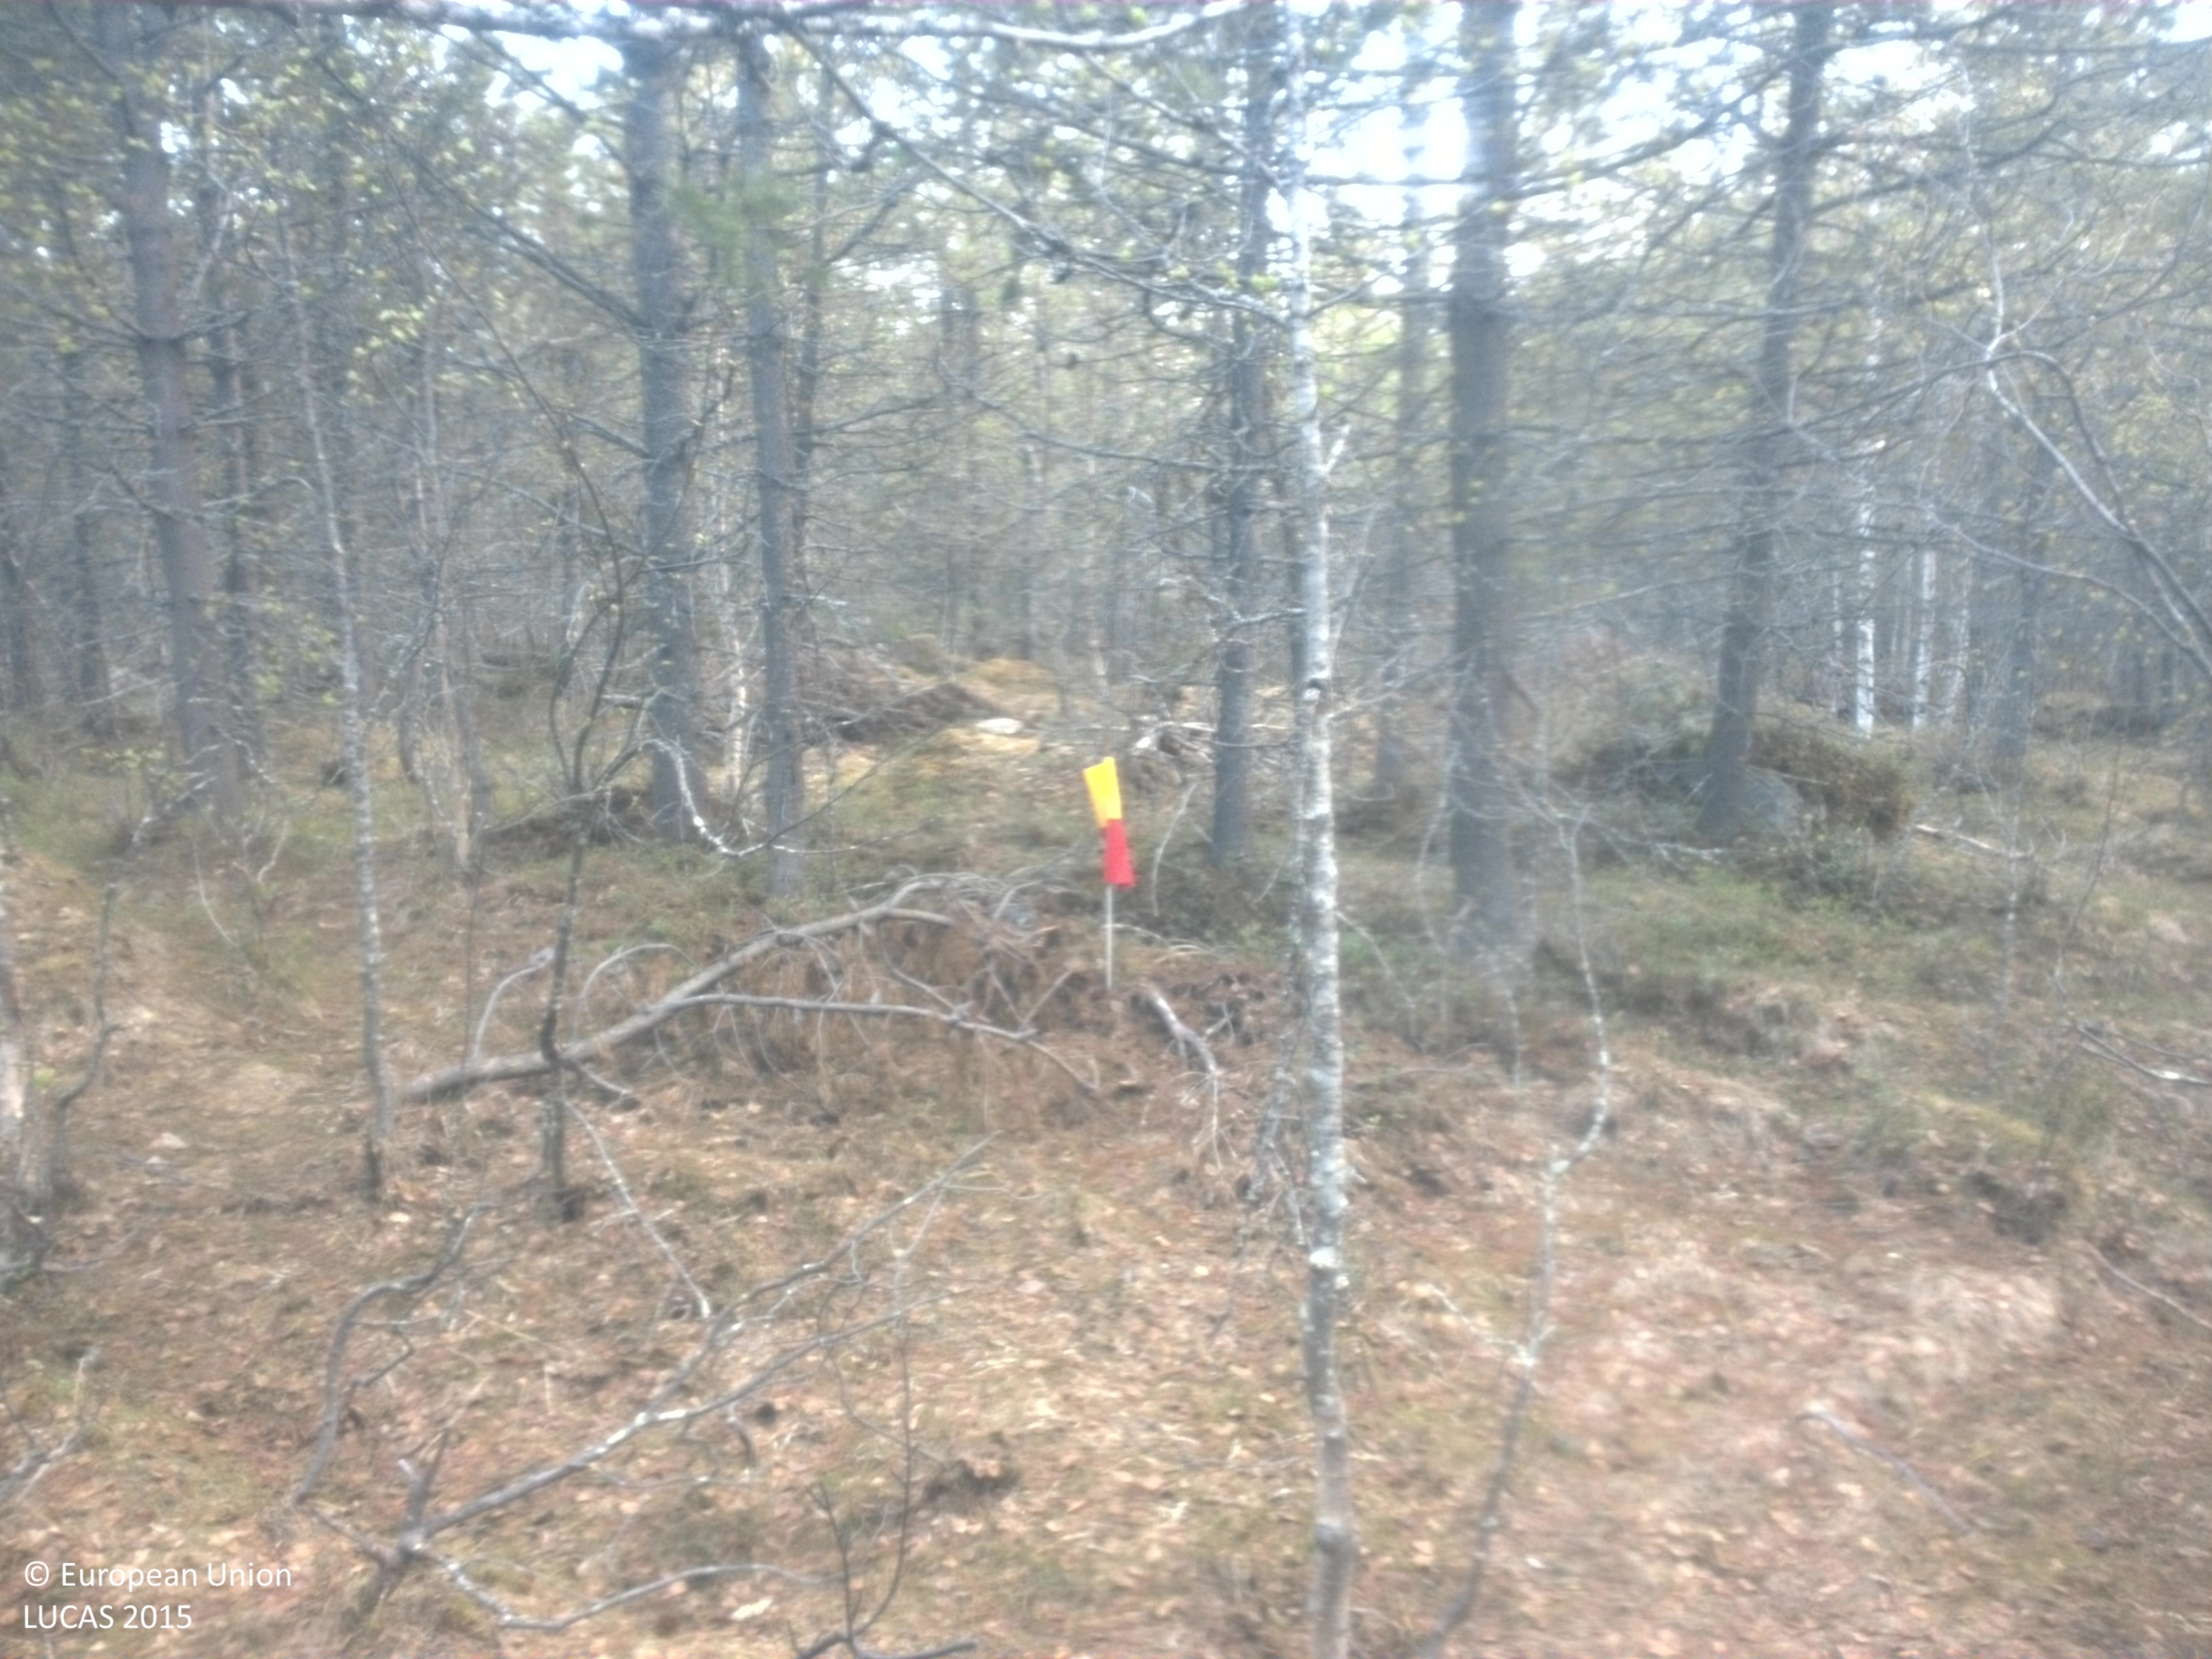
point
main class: Woodland
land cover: Pine dominated mixed woodland
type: exotic forest
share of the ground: 50 - 75 %
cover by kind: coniferous forest trees 45 %, herbaceous plants 20 %, broadleaved forest trees 15 %, lichens and mosses 10 %, shrubs 5 %, unconsolidated bare surface 5 %
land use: Forestry
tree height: > 5 m
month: June
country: SE
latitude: 64.4981
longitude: 17.7737
